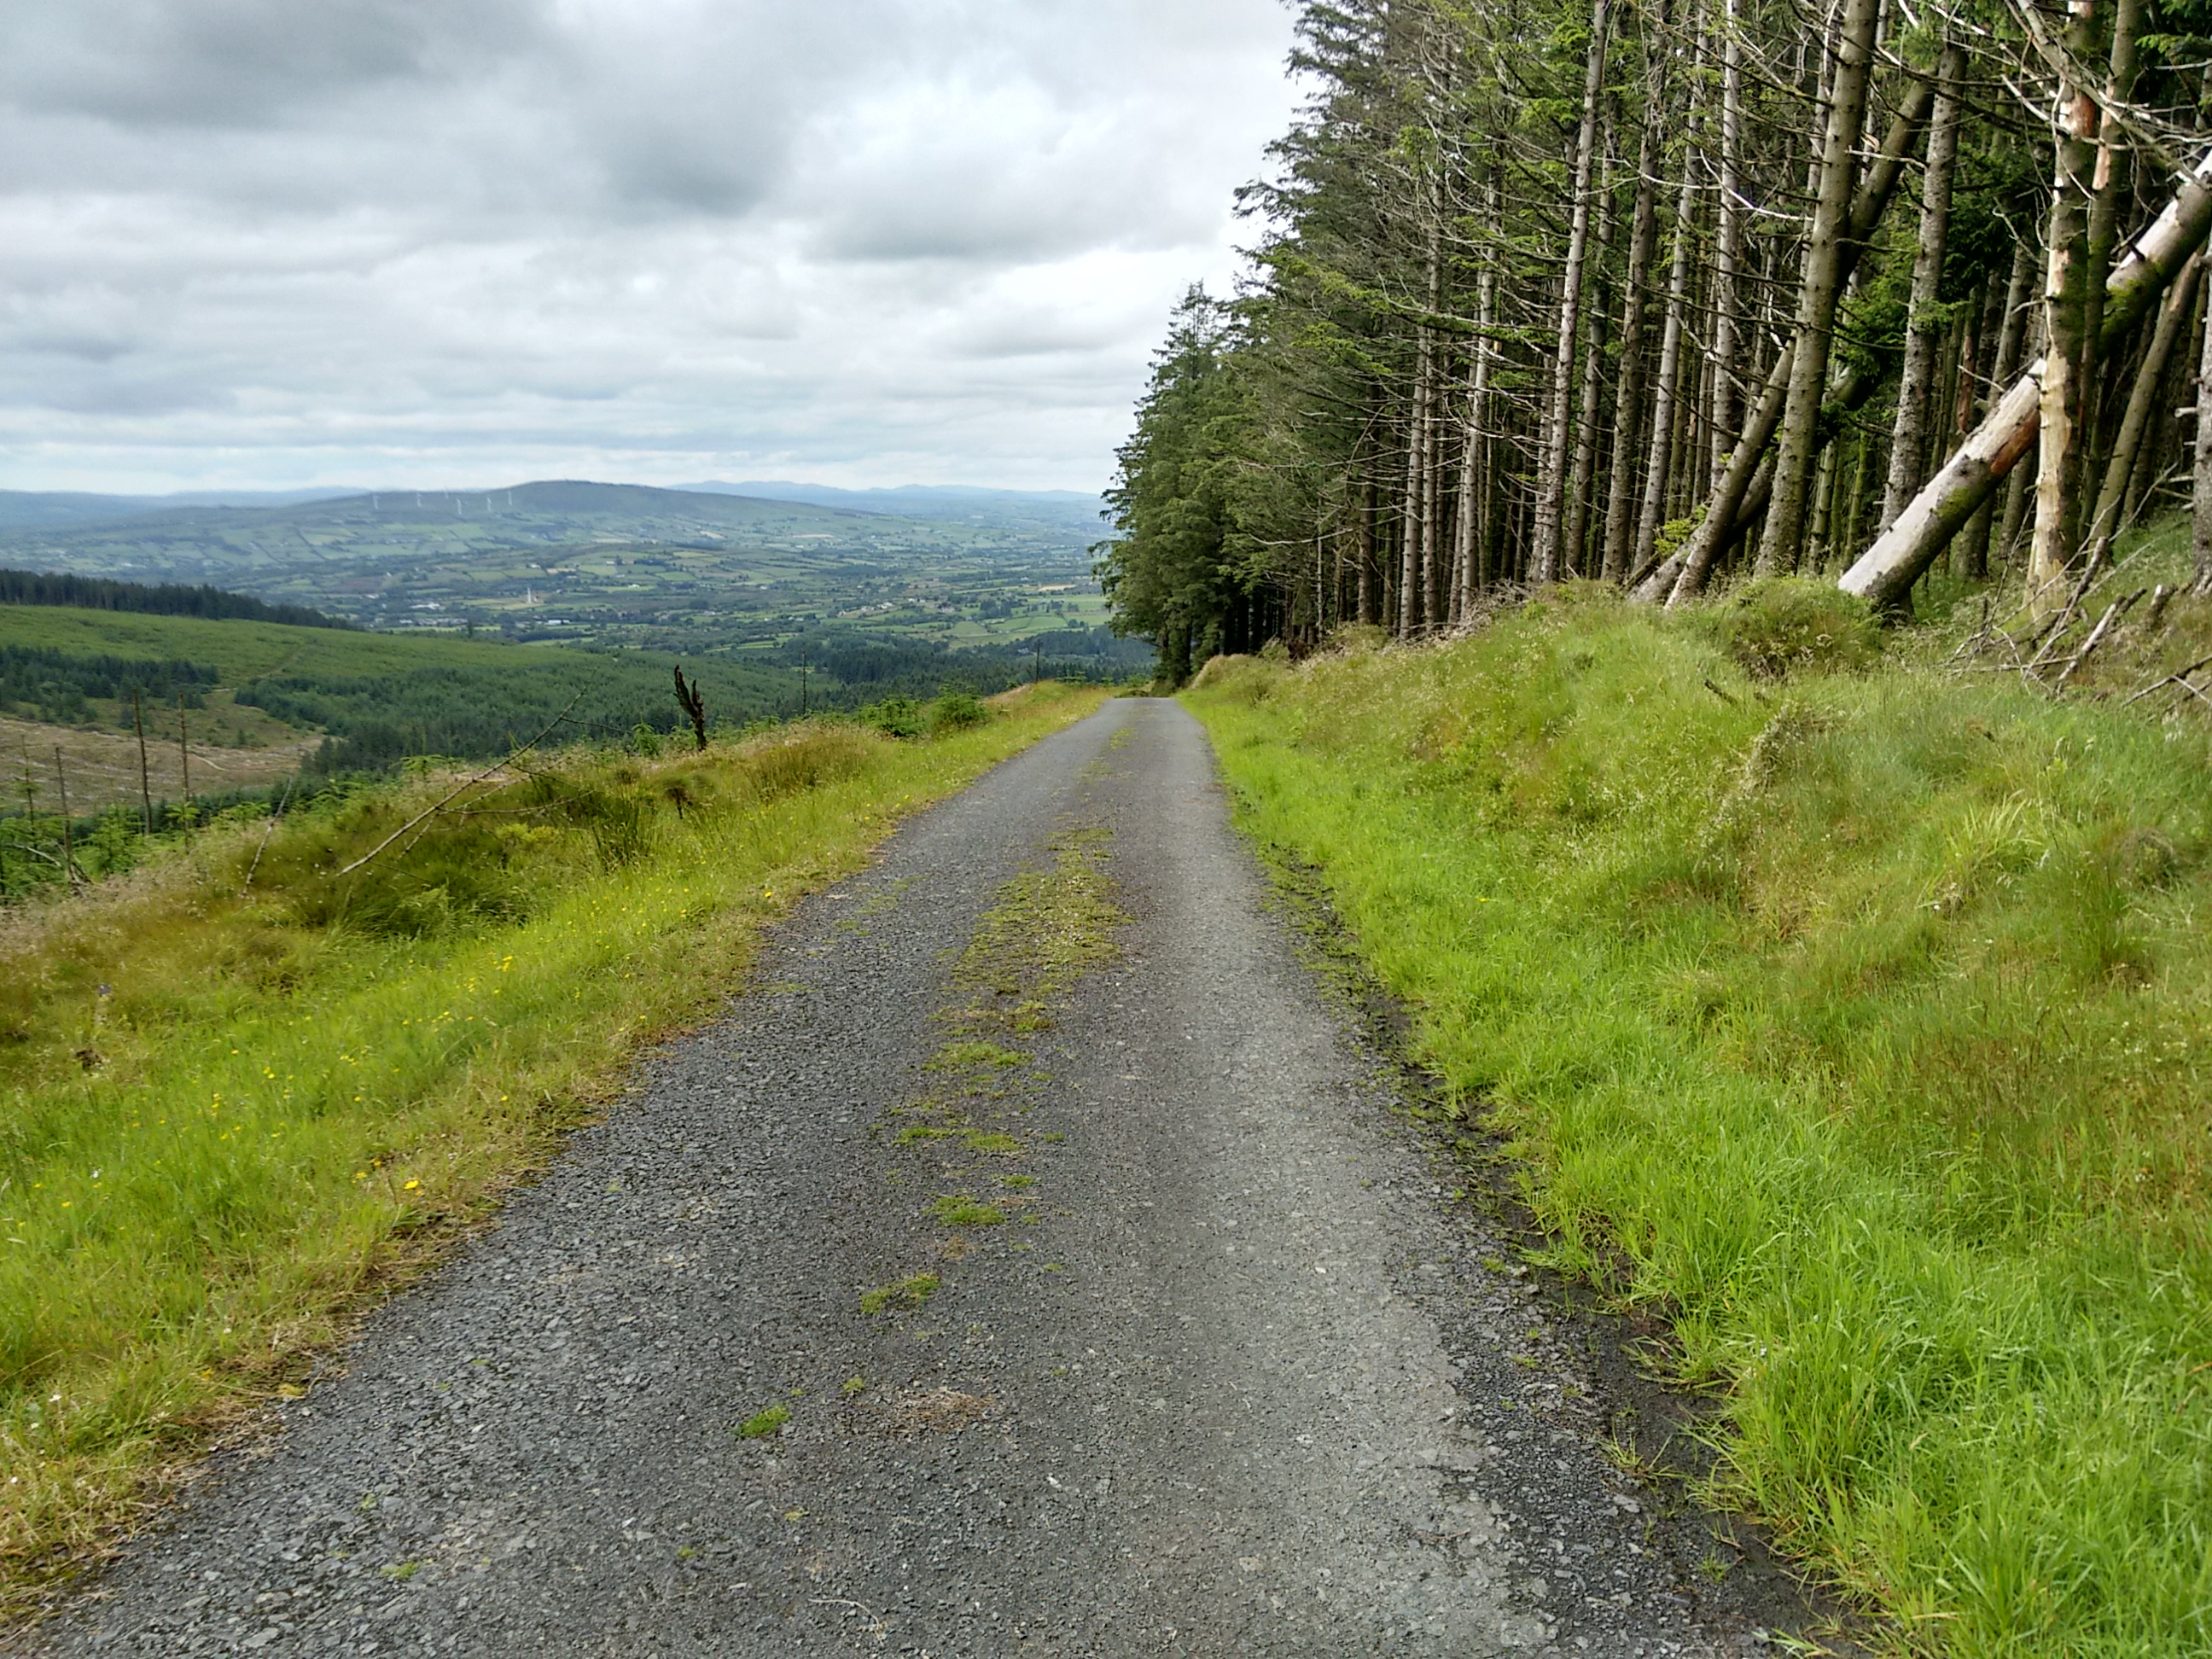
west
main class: Woodland
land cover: Spruce dominated coniferous woodland
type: exotic forest
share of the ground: > 75 %
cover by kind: coniferous forest trees 100 %
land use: Forestry
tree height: > 5 m
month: July
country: GB
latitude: 54.6779
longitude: -7.2213
